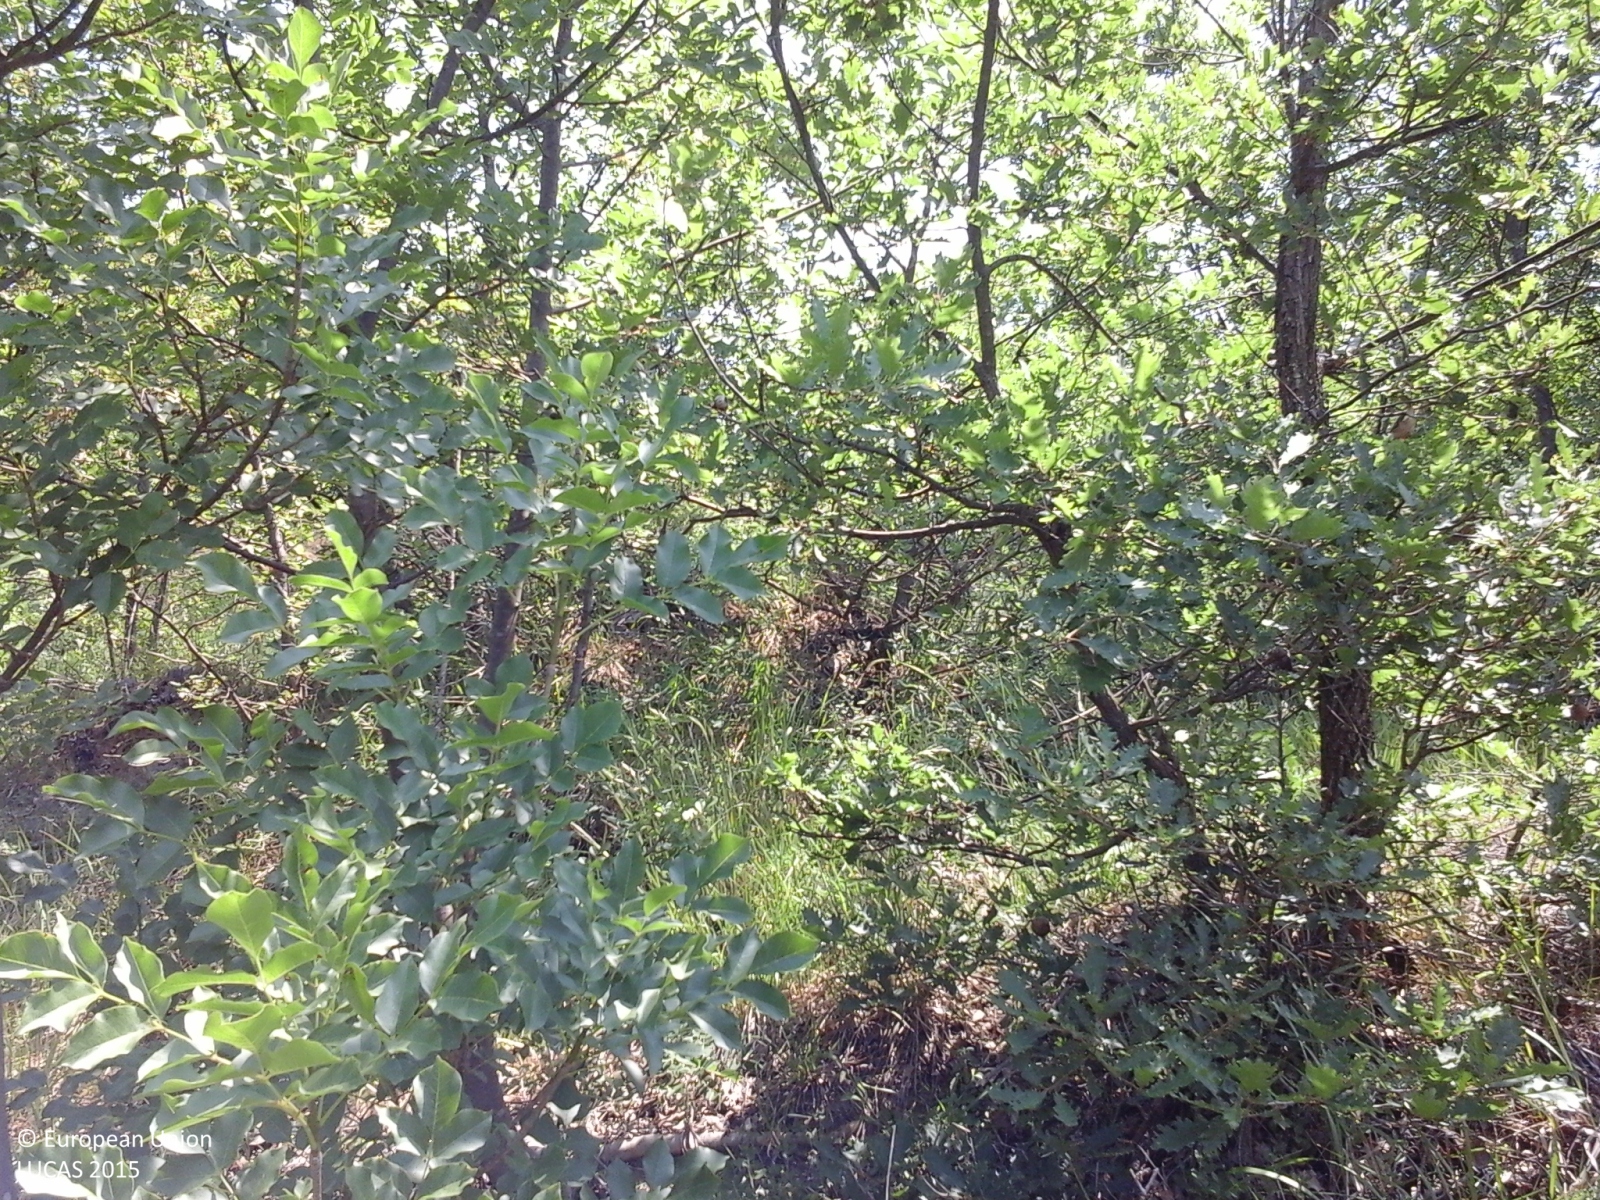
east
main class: Woodland
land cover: Broadleaved woodland
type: thermophilous deciduous forest
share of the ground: 50 - 75 %
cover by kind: broadleaved forest trees 70 %, shrubs 20 %, herbaceous plants 10 %
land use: Forestry
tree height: < 5 m
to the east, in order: Broadleaved woodland; Grassland without tree/shrub cover; Tracks; Broadleaved woodland
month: June
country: IT
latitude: 44.5187
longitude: 8.4056
